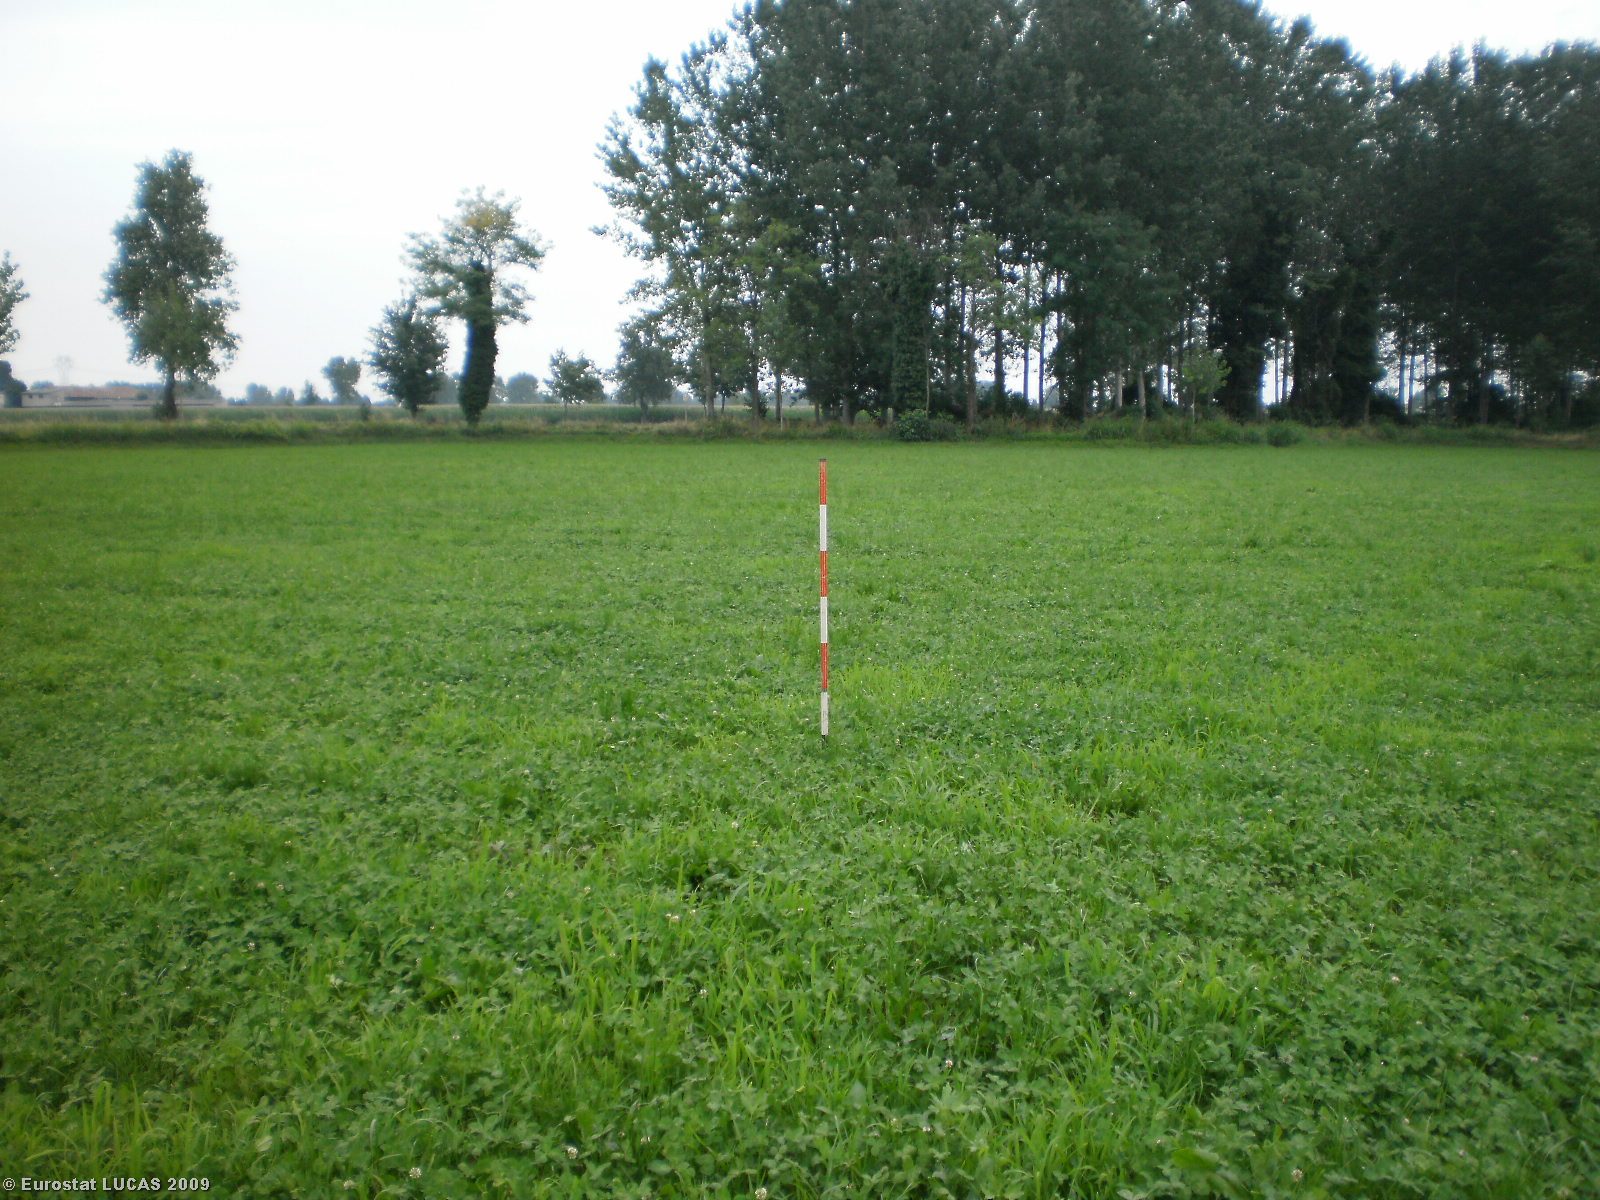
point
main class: Cropland
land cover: Clovers
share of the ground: > 75 %
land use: Agriculture (excluding fallow land and kitchen gardens)
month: July
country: IT
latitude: 45.3952
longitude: 9.5282
